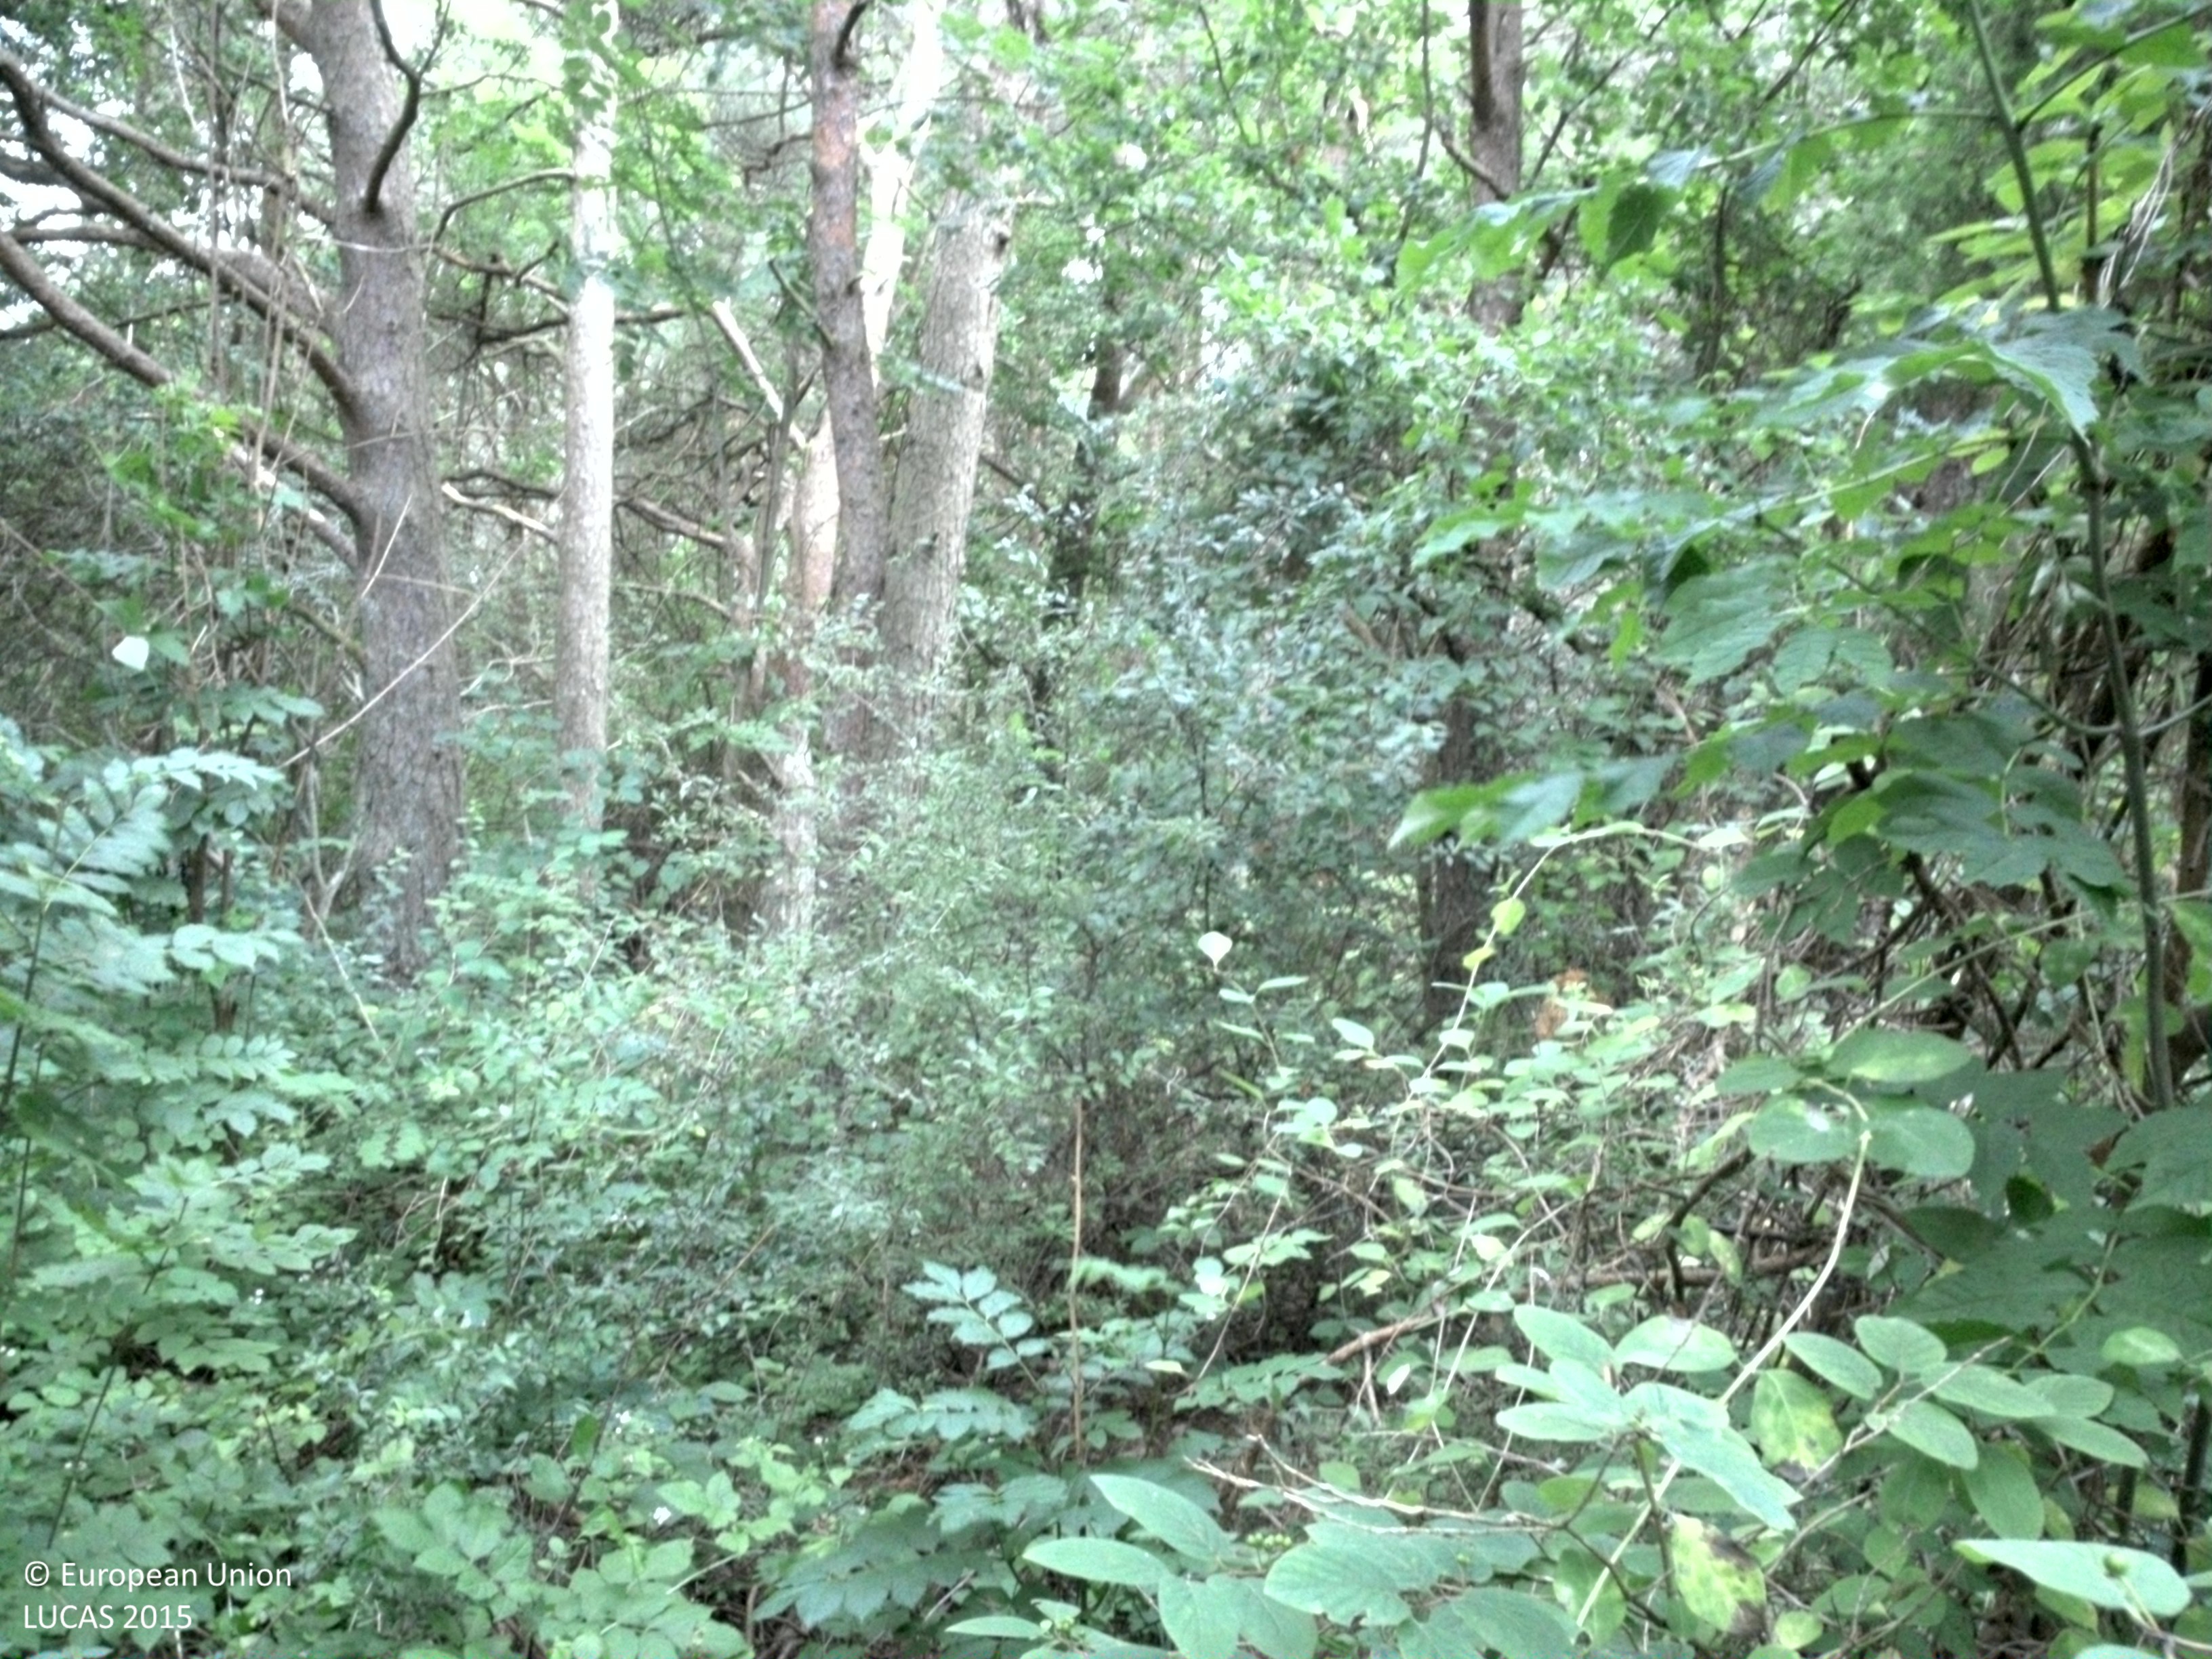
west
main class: Woodland
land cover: Pine dominated coniferous woodland
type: hemiboreal forest and nemoral coniferous forest and mixed broadleaved-coniferous forest
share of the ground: > 75 %
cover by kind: coniferous forest trees 75 %, shrubs 15 %, broadleaved forest trees 5 %, herbaceous plants 5 %
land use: Forestry
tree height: > 5 m
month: July
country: SE
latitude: 57.2214
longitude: 18.5723
